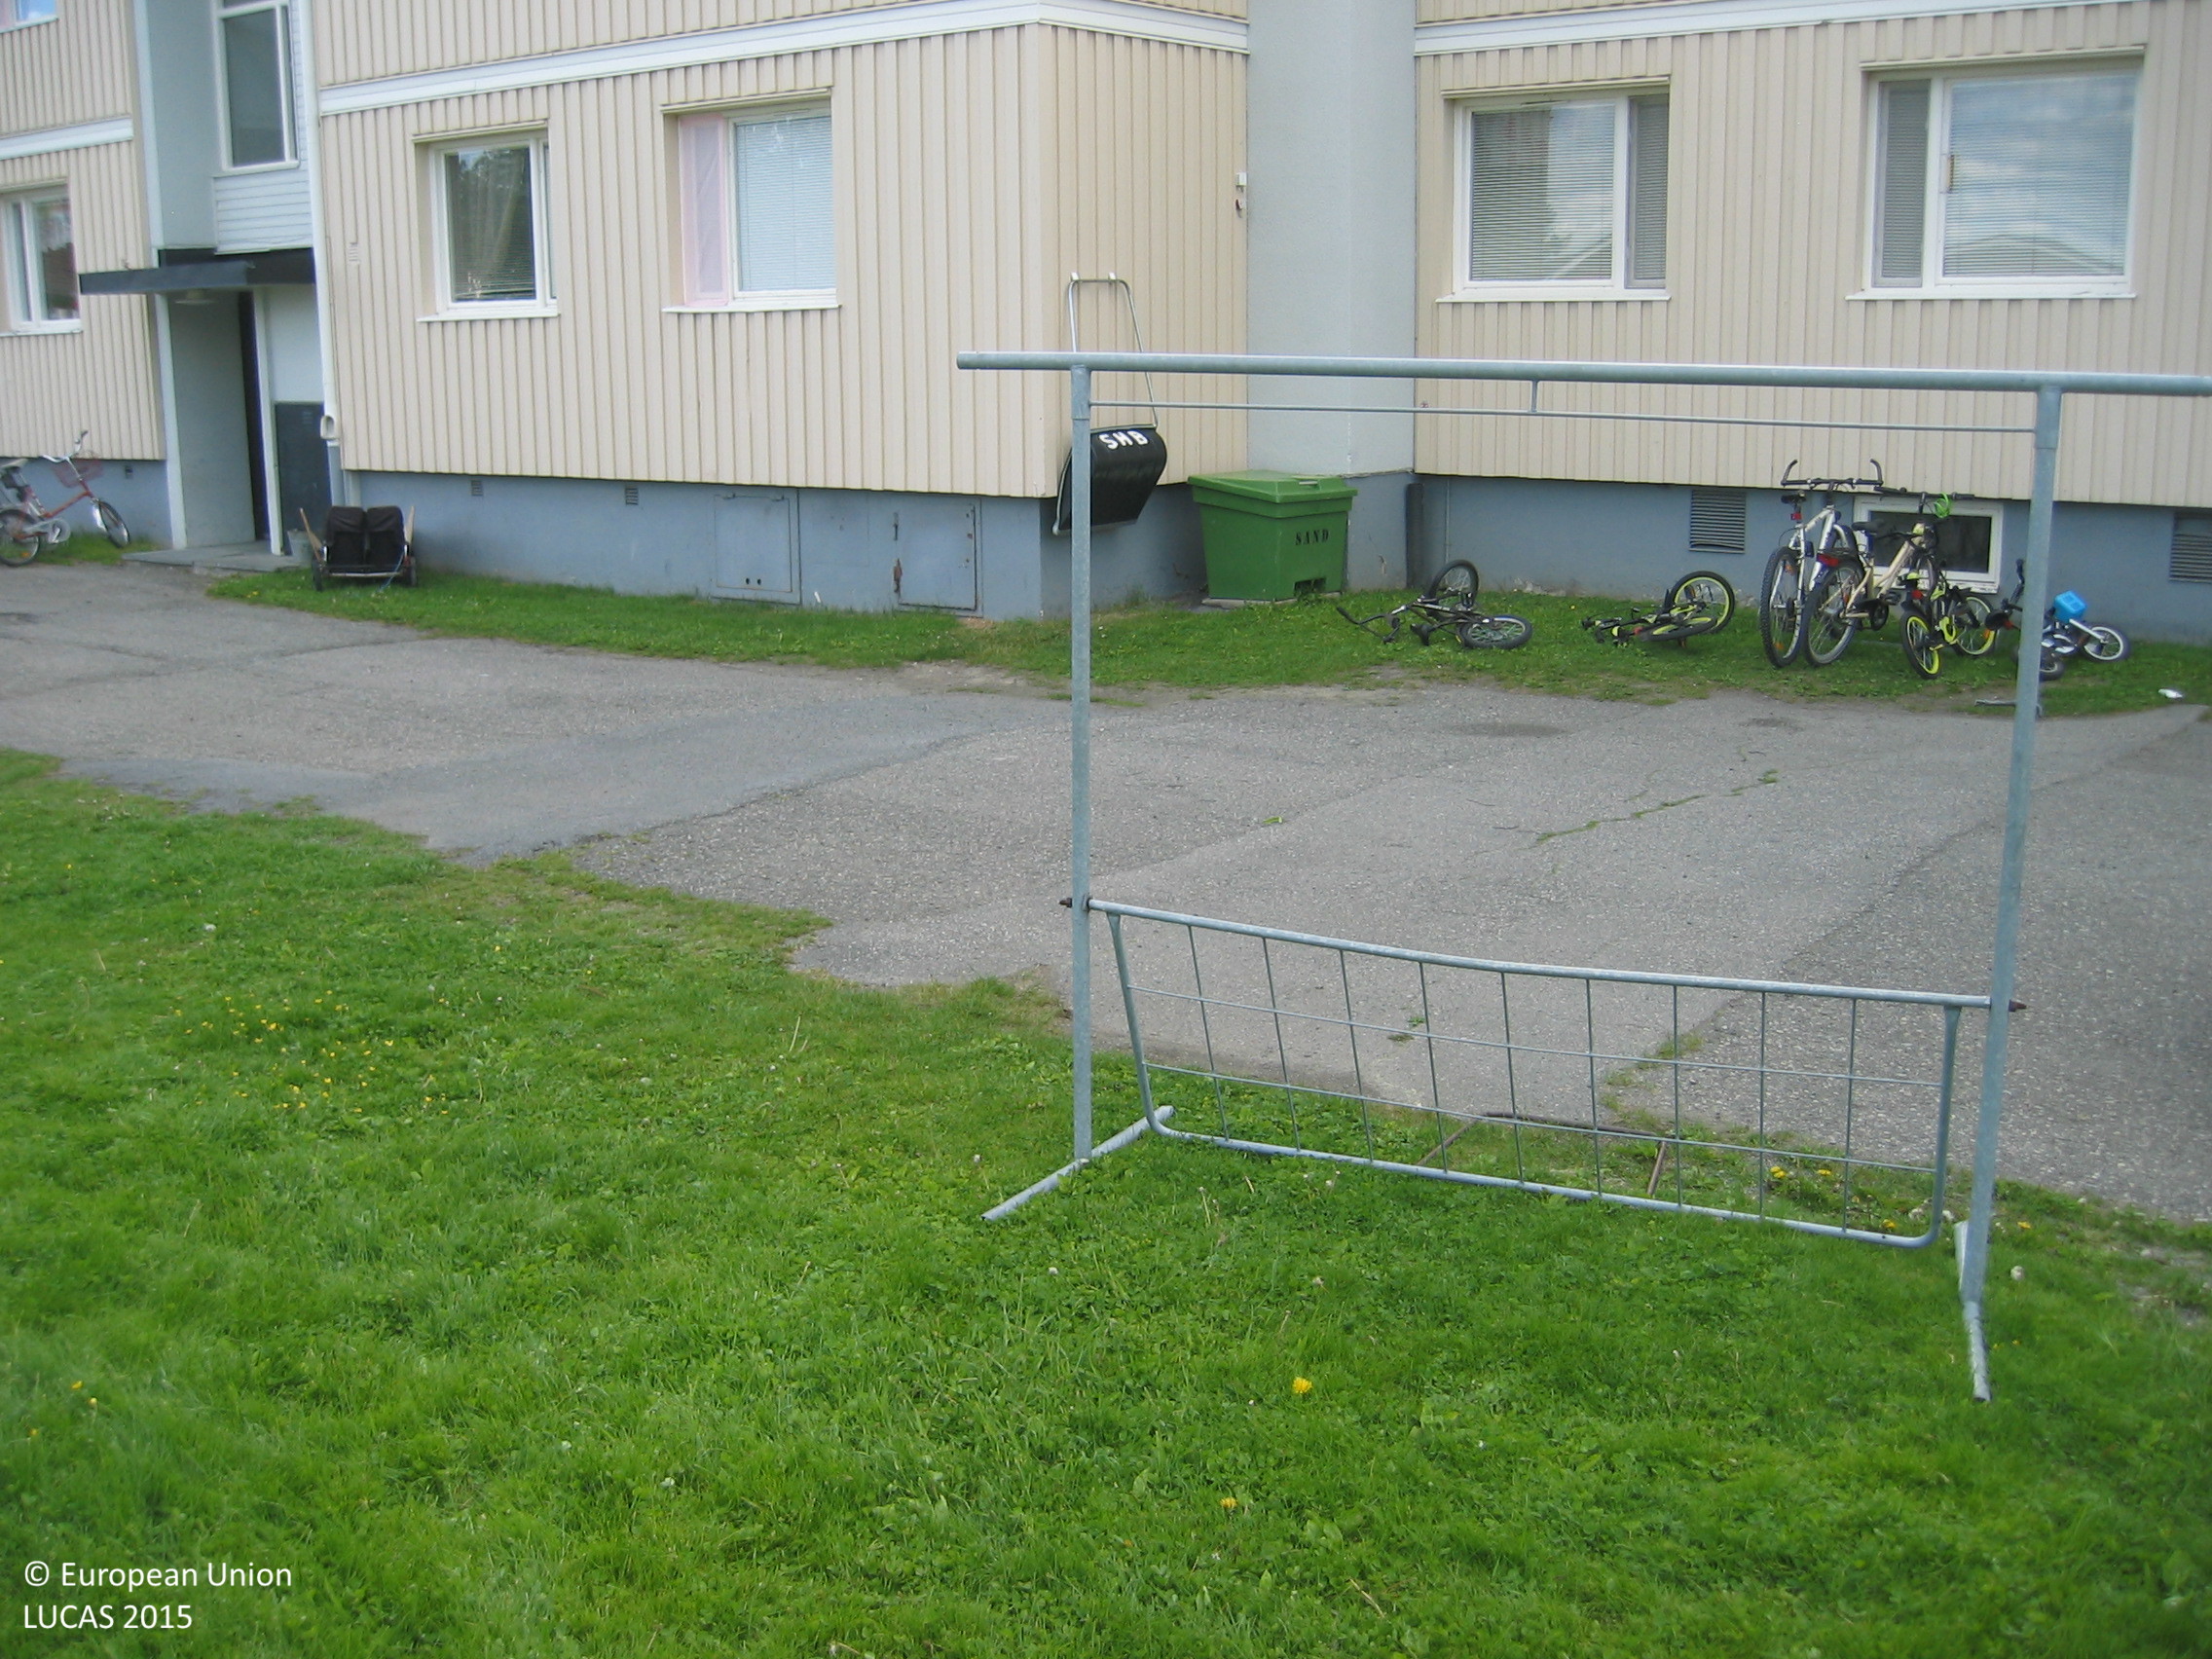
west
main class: Grassland
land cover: Grassland with sparse tree/shrub cover
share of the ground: > 75 %
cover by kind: herbaceous plants 95 %, broadleaved forest trees 5 %
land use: Residential
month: June
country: SE
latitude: 63.5840
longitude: 15.3543
